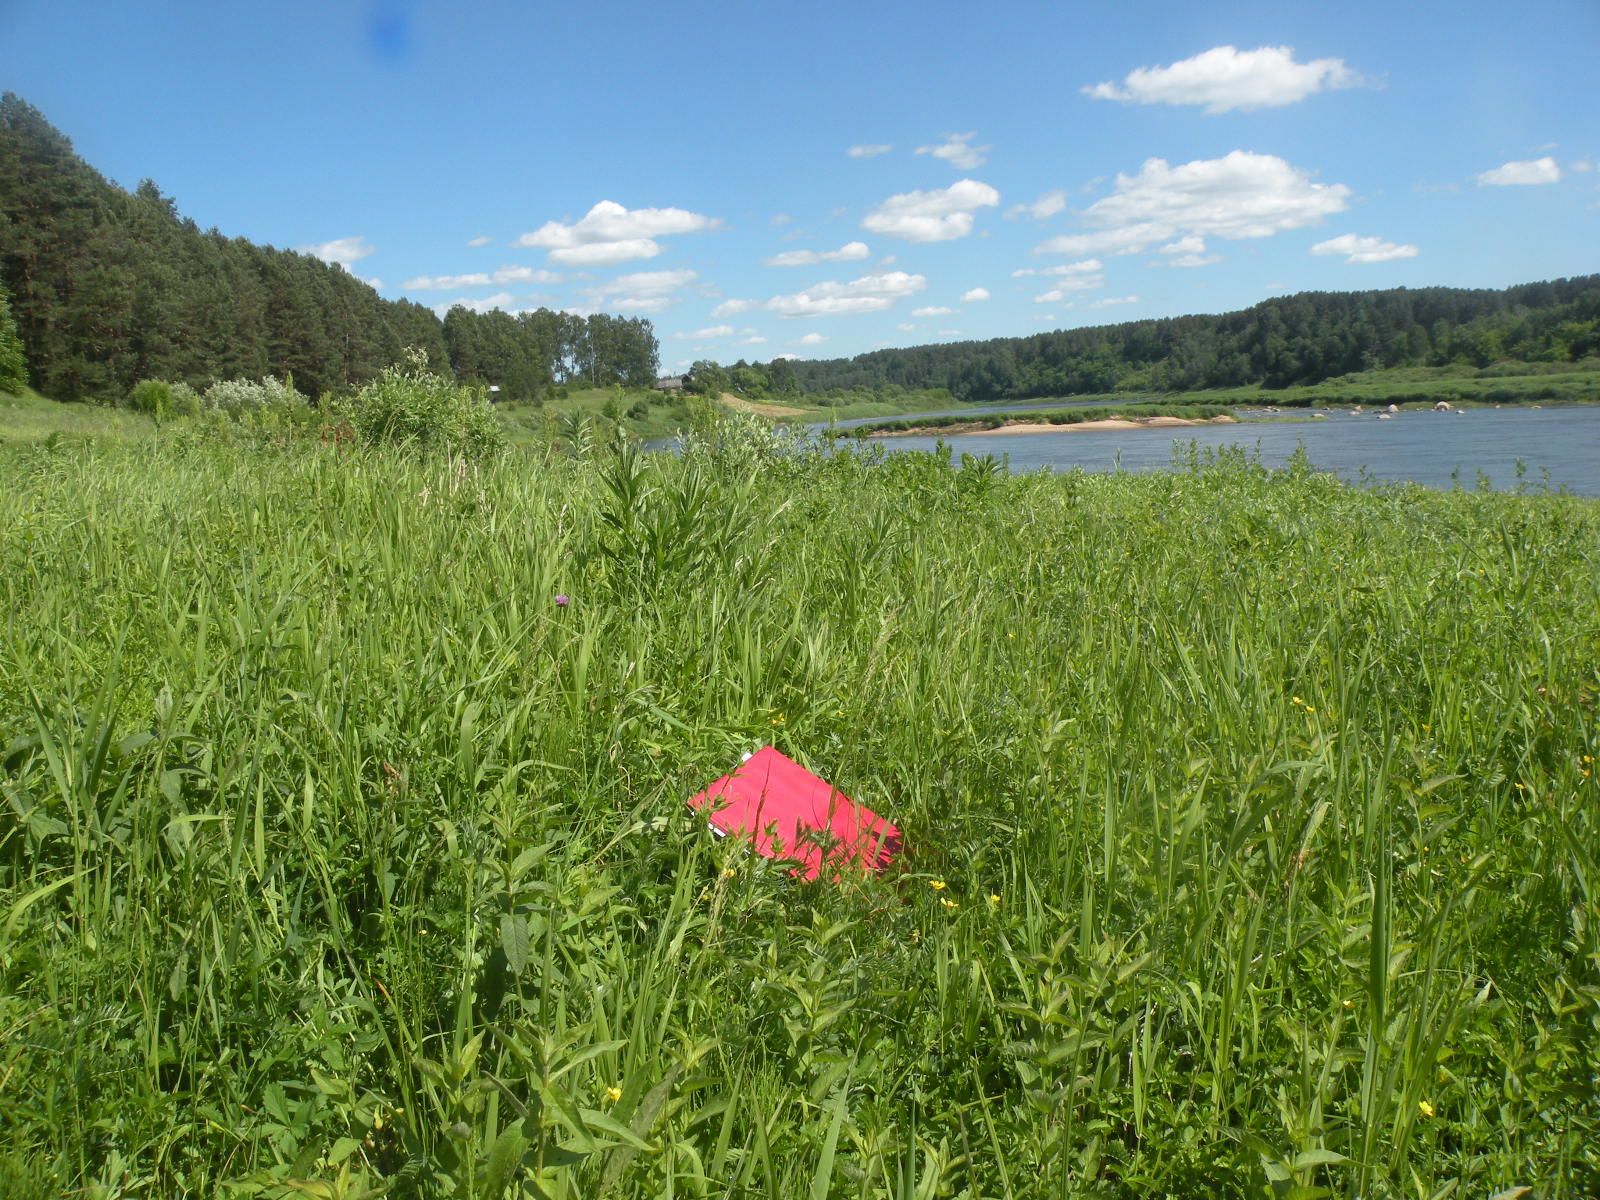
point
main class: Grassland
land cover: Spontaneously vegetated surfaces
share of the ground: > 75 %
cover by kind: herbaceous plants 100 %
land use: Semi-natural and natural areas not in use
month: June
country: LV
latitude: 55.8705
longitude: 26.9941
